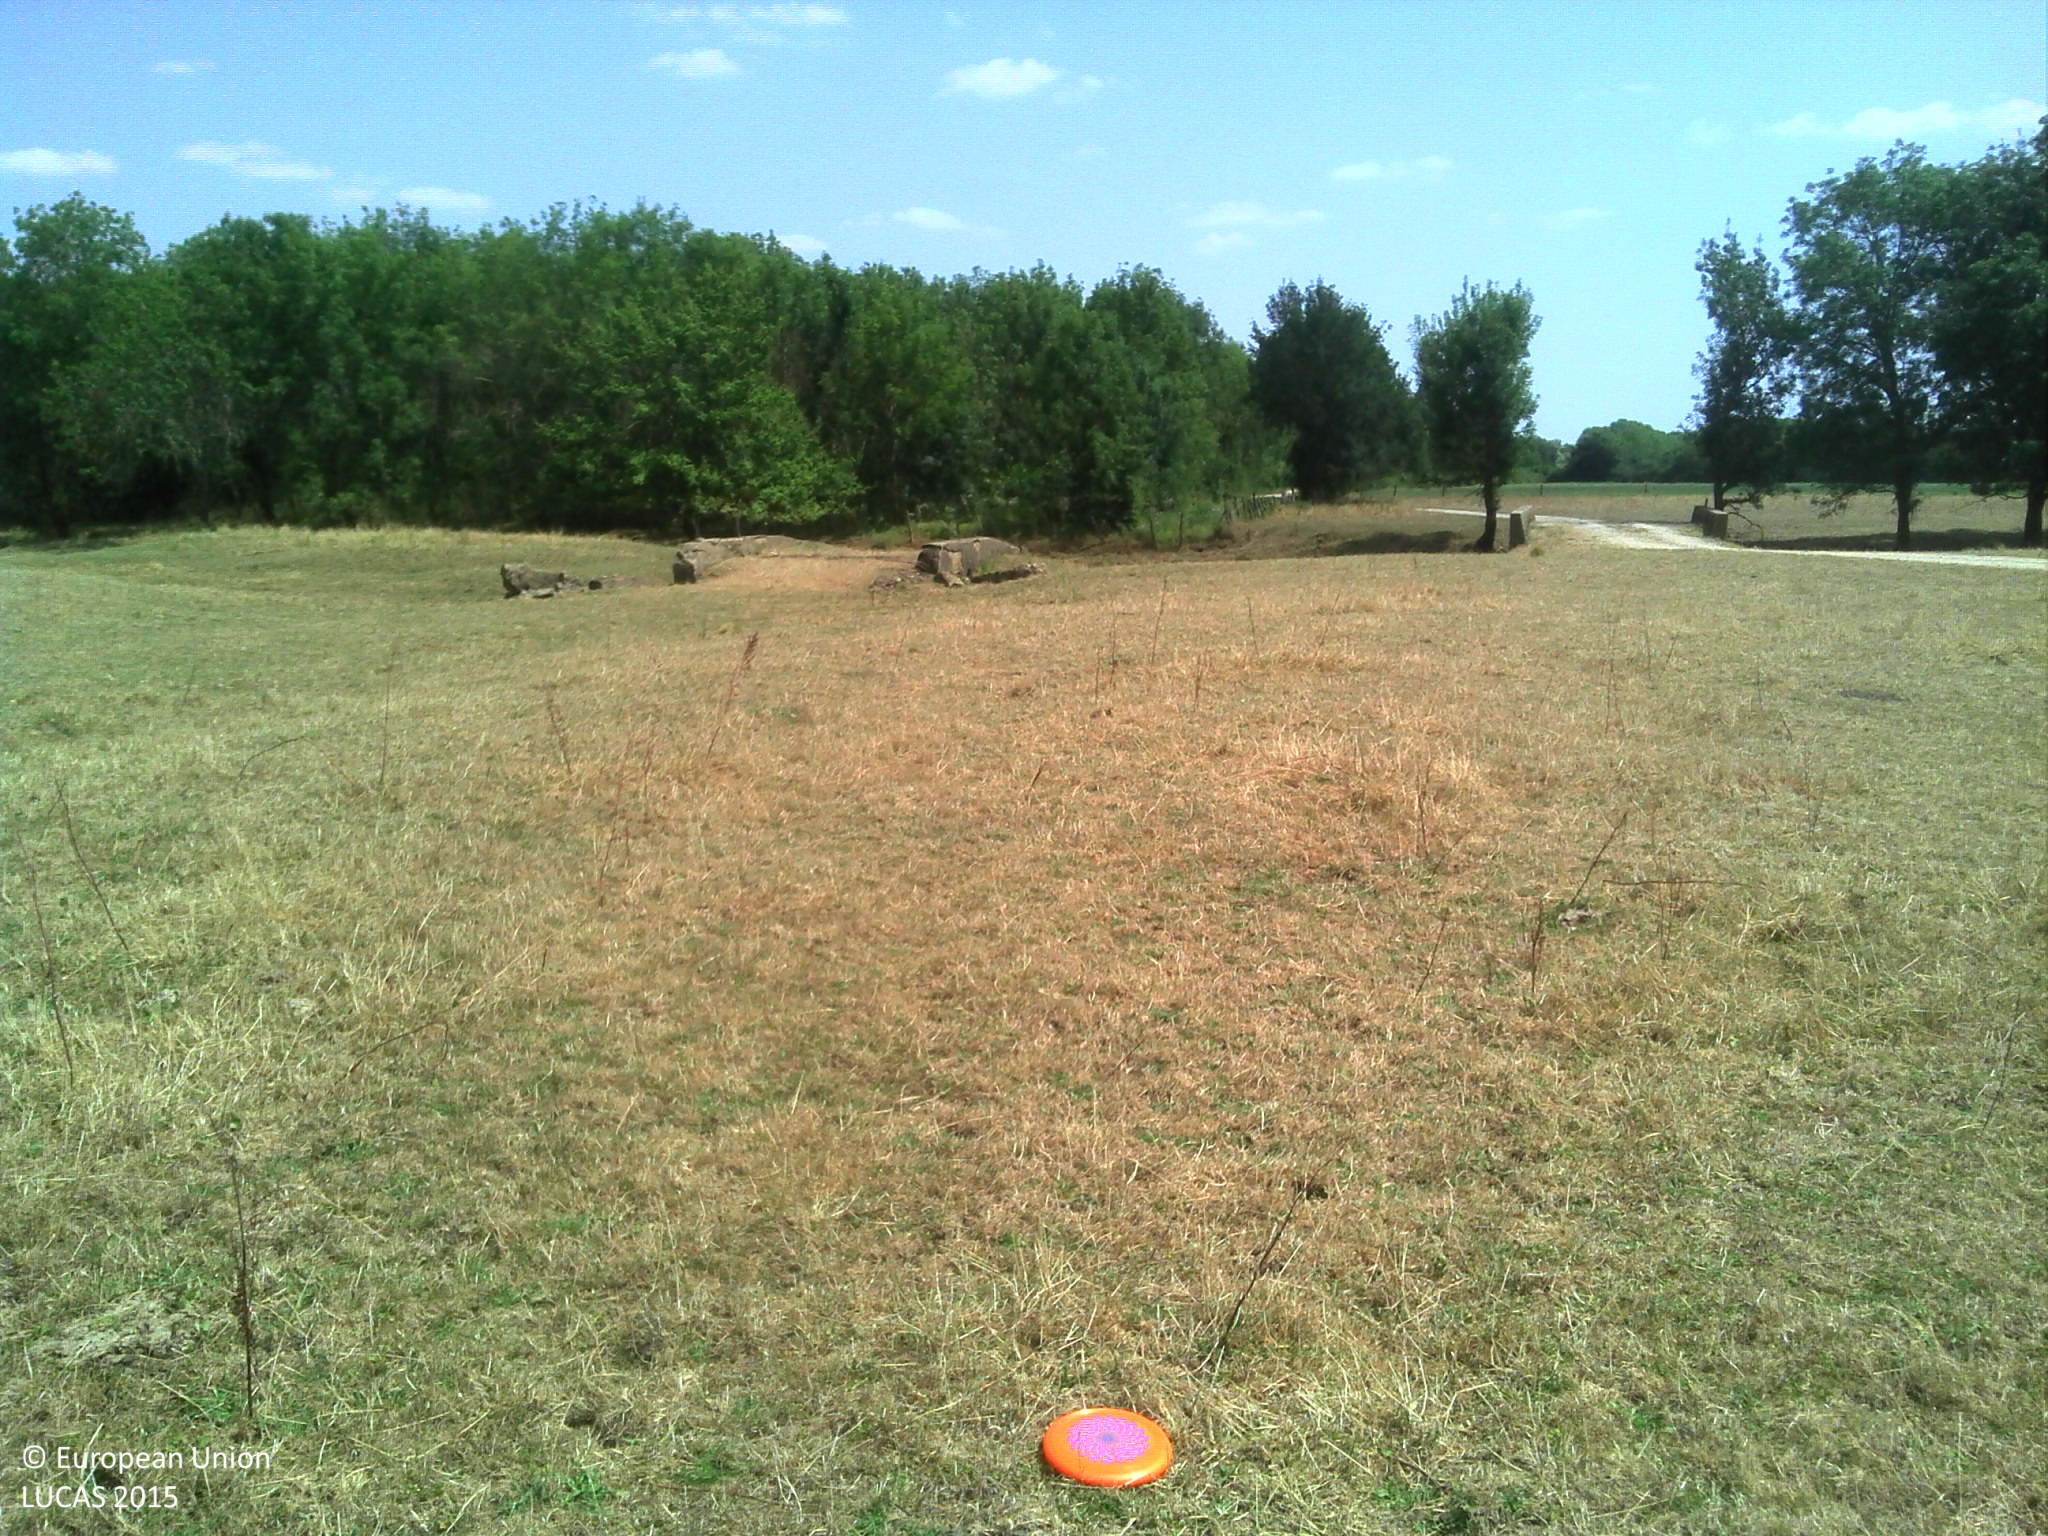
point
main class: Grassland
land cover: Grassland without tree/shrub cover
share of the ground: > 75 %
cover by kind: herbaceous plants 100 %
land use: Agriculture (excluding fallow land and kitchen gardens)
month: July
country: FR
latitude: 46.9414
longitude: 5.0750
